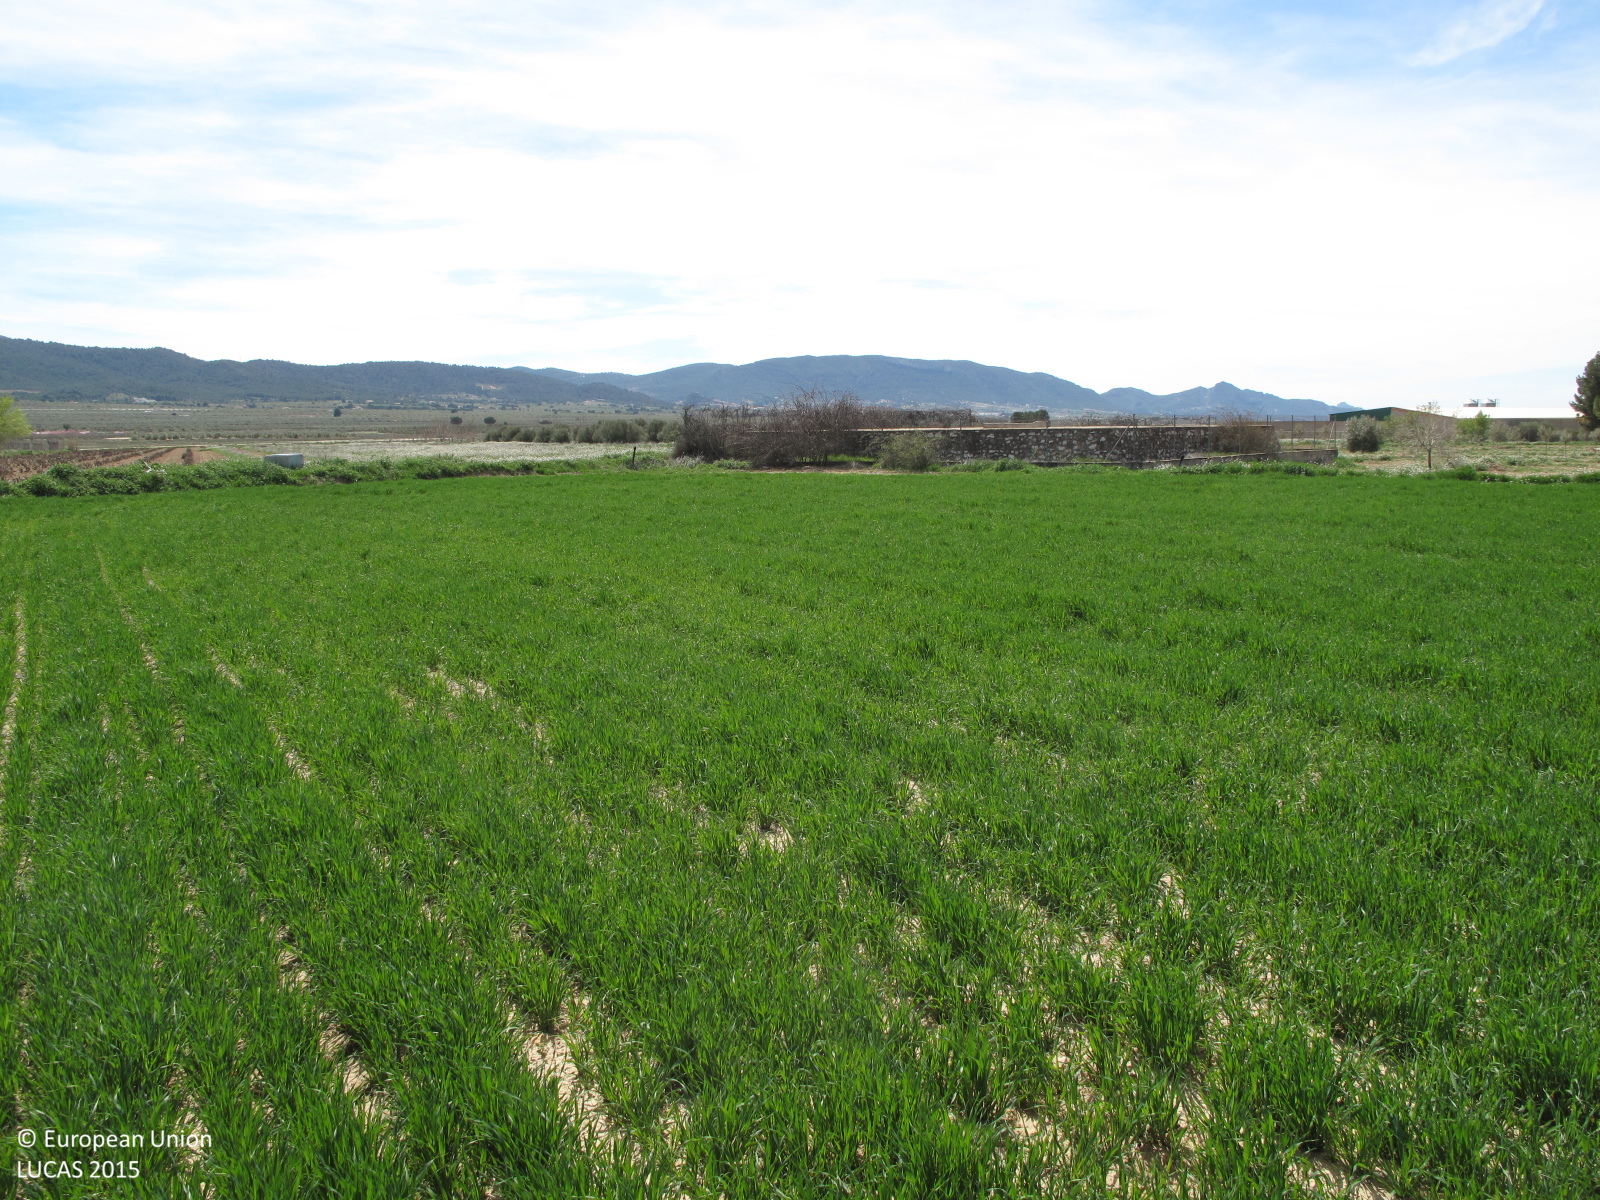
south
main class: Cropland
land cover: Barley
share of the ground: > 75 %
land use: Agriculture (excluding fallow land and kitchen gardens)
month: March
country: ES
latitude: 38.6880
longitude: -0.7625
